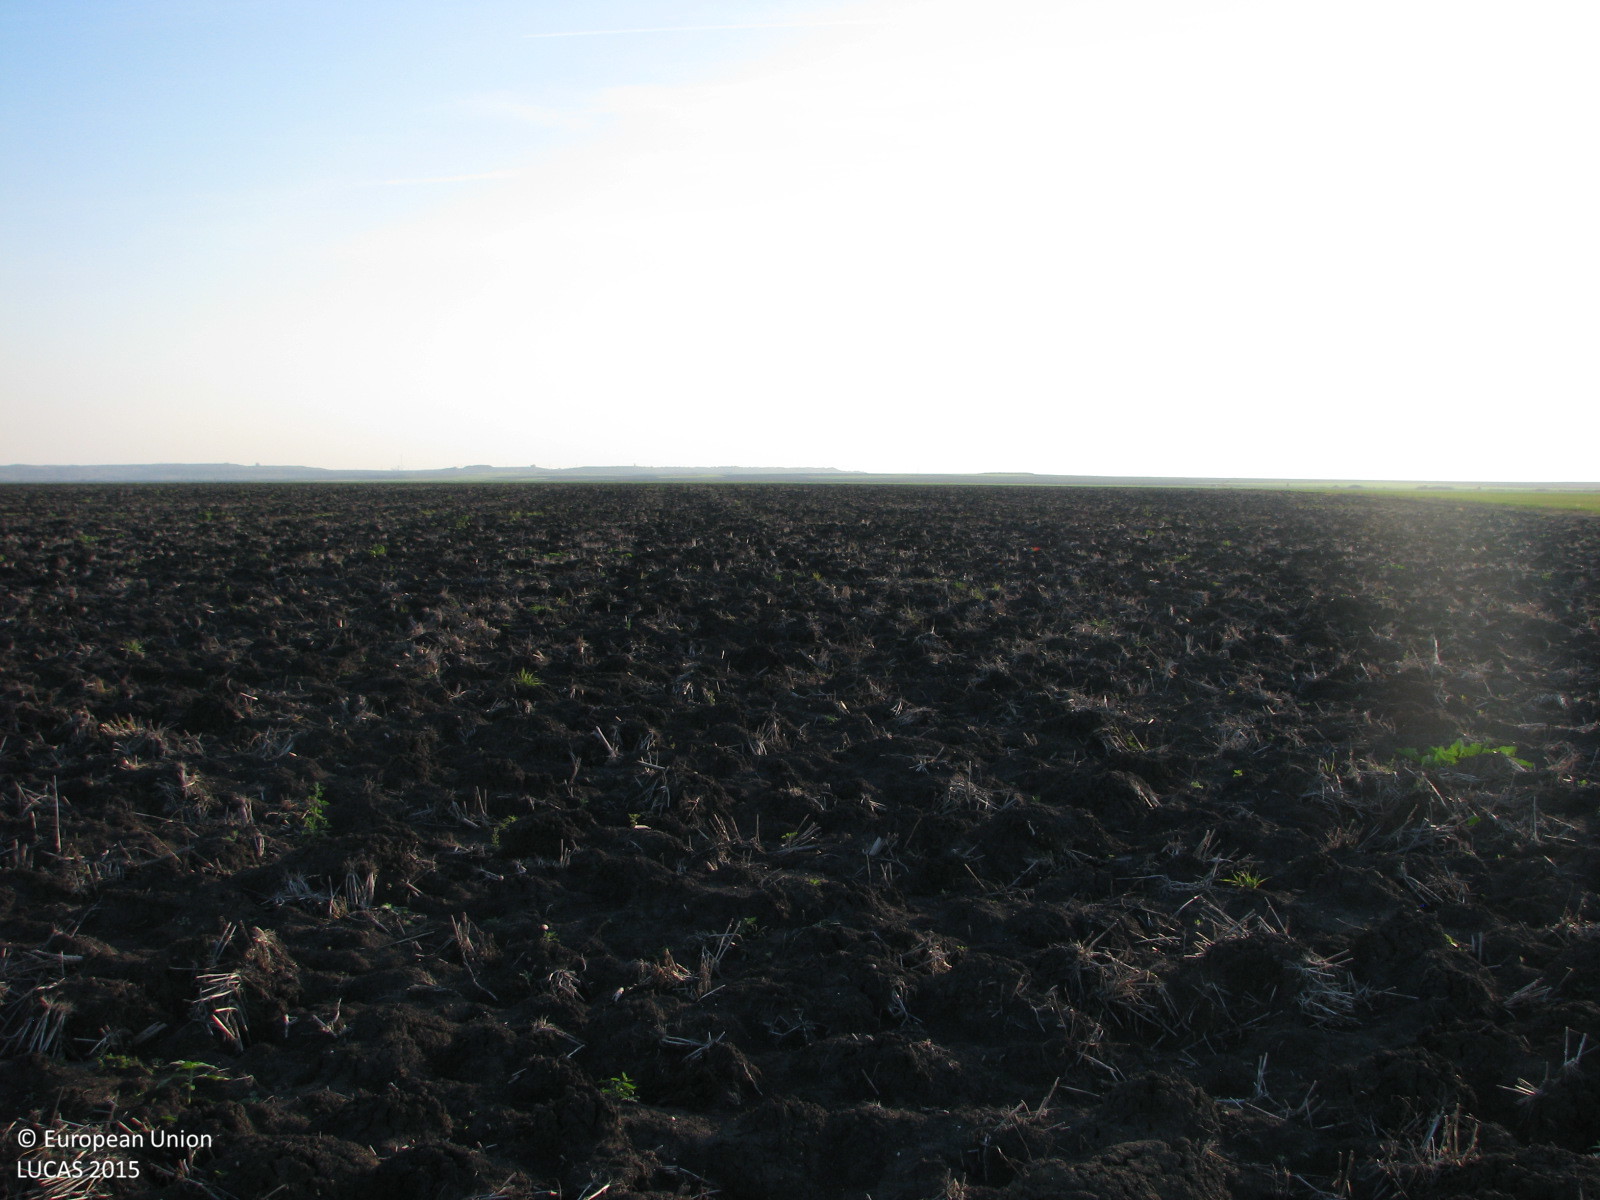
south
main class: Cropland
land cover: Common wheat
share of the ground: < 10 %
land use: Agriculture (excluding fallow land and kitchen gardens)
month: November
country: BG
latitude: 42.3436
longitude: 26.0168
